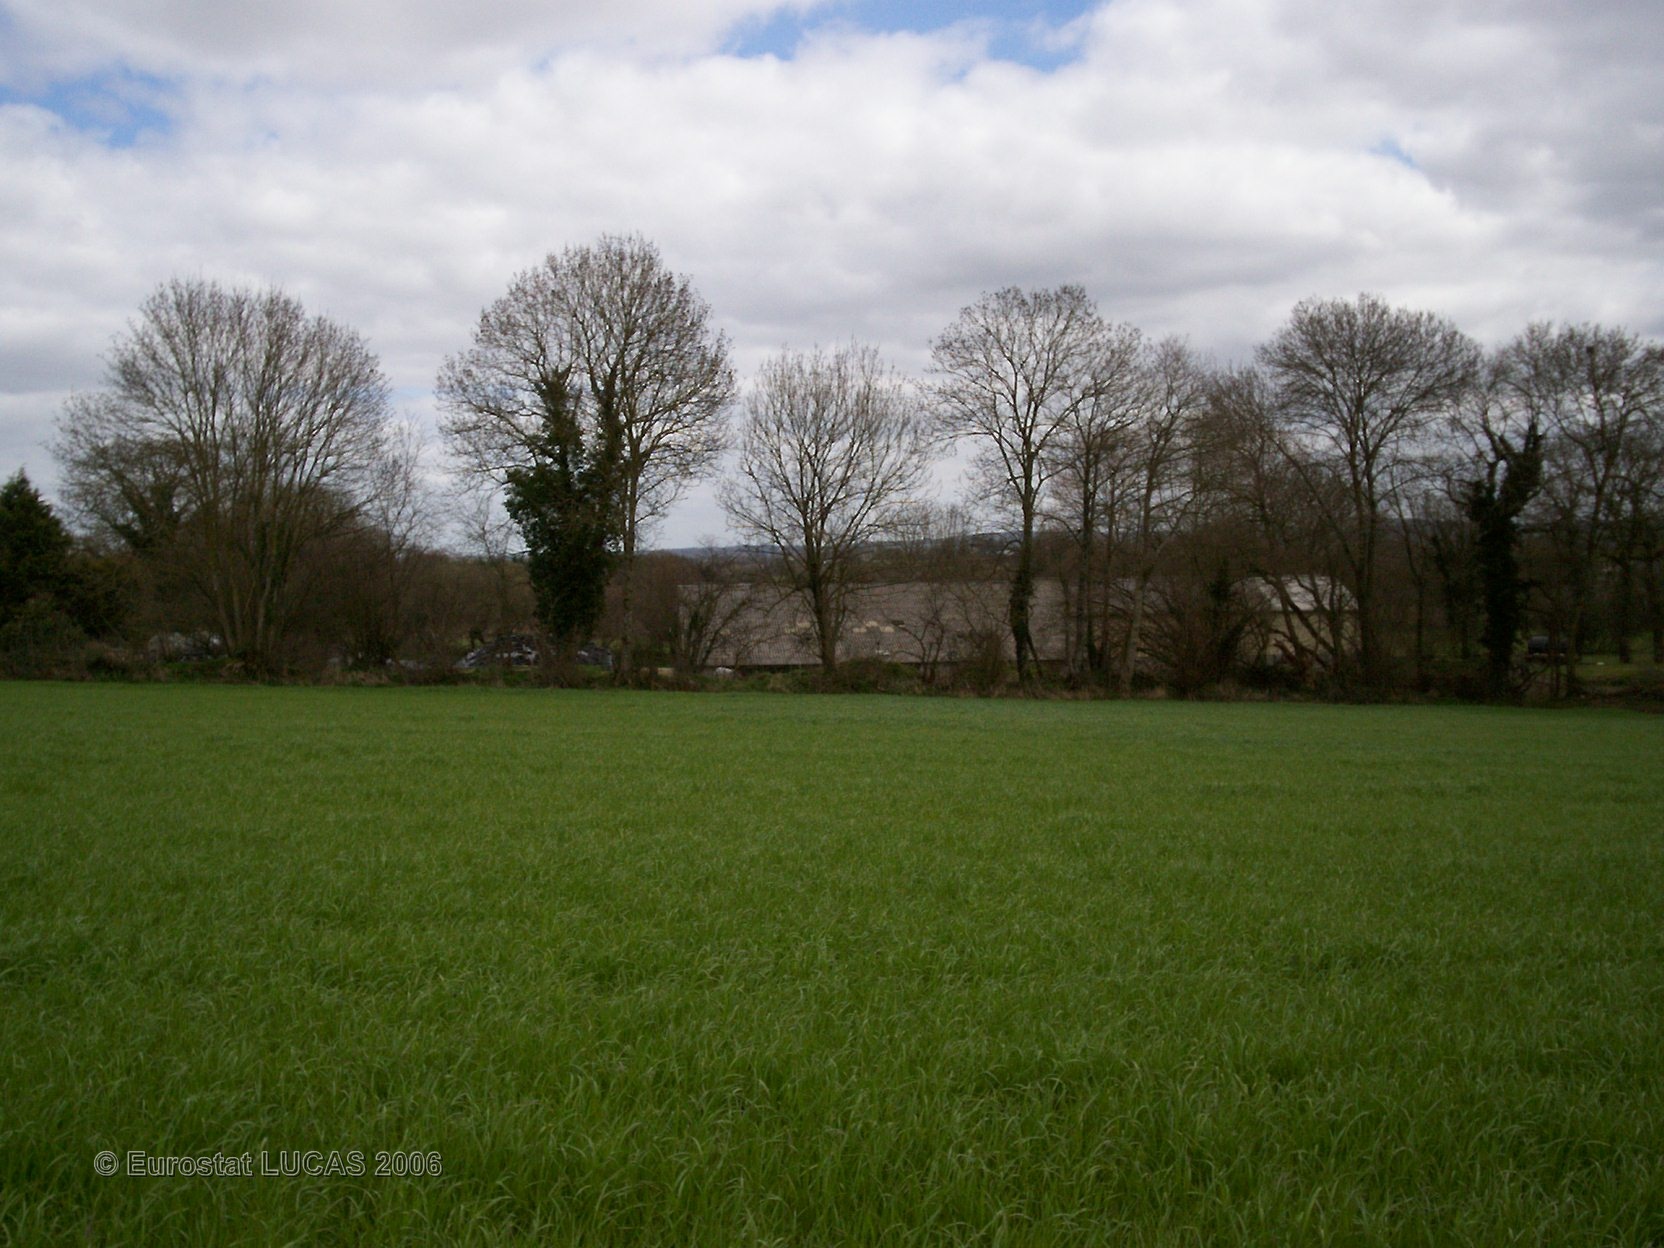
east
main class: Grassland
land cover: Grassland without tree/shrub cover
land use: Agriculture (excluding fallow land and kitchen gardens)
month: April
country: FR
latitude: 48.2145
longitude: -3.6053
